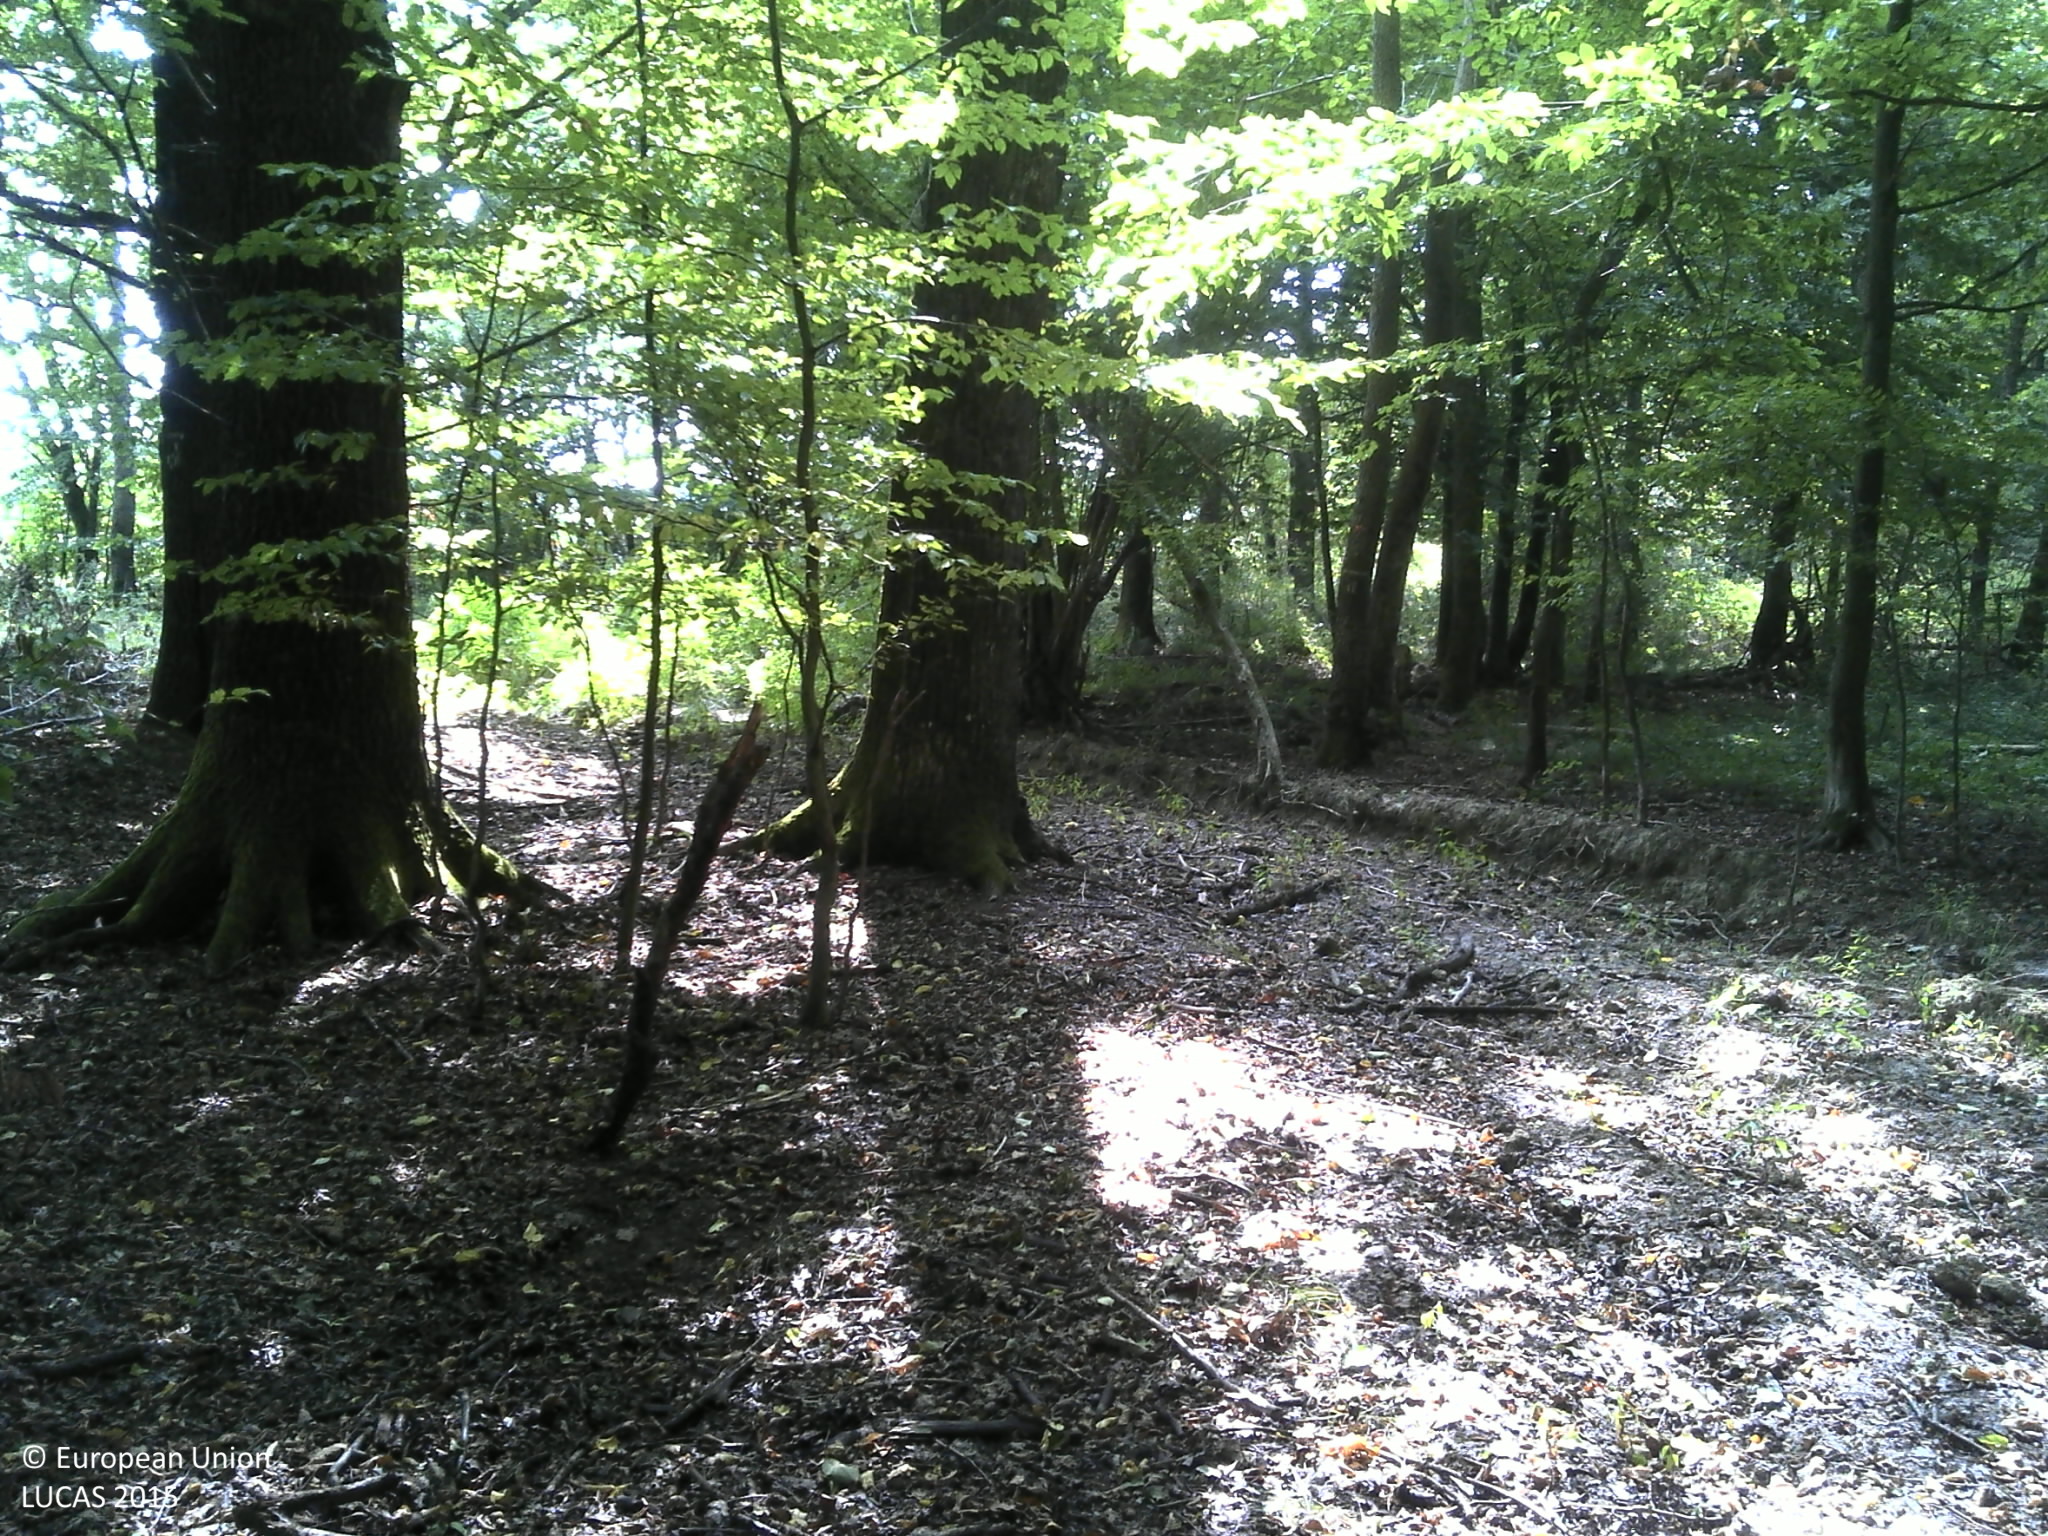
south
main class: Woodland
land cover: Broadleaved woodland
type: mesophytic deciduous forest
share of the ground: > 75 %
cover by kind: broadleaved forest trees 100 %
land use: Forestry
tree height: > 5 m
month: September
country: HR
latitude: 45.6963
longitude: 16.5872
